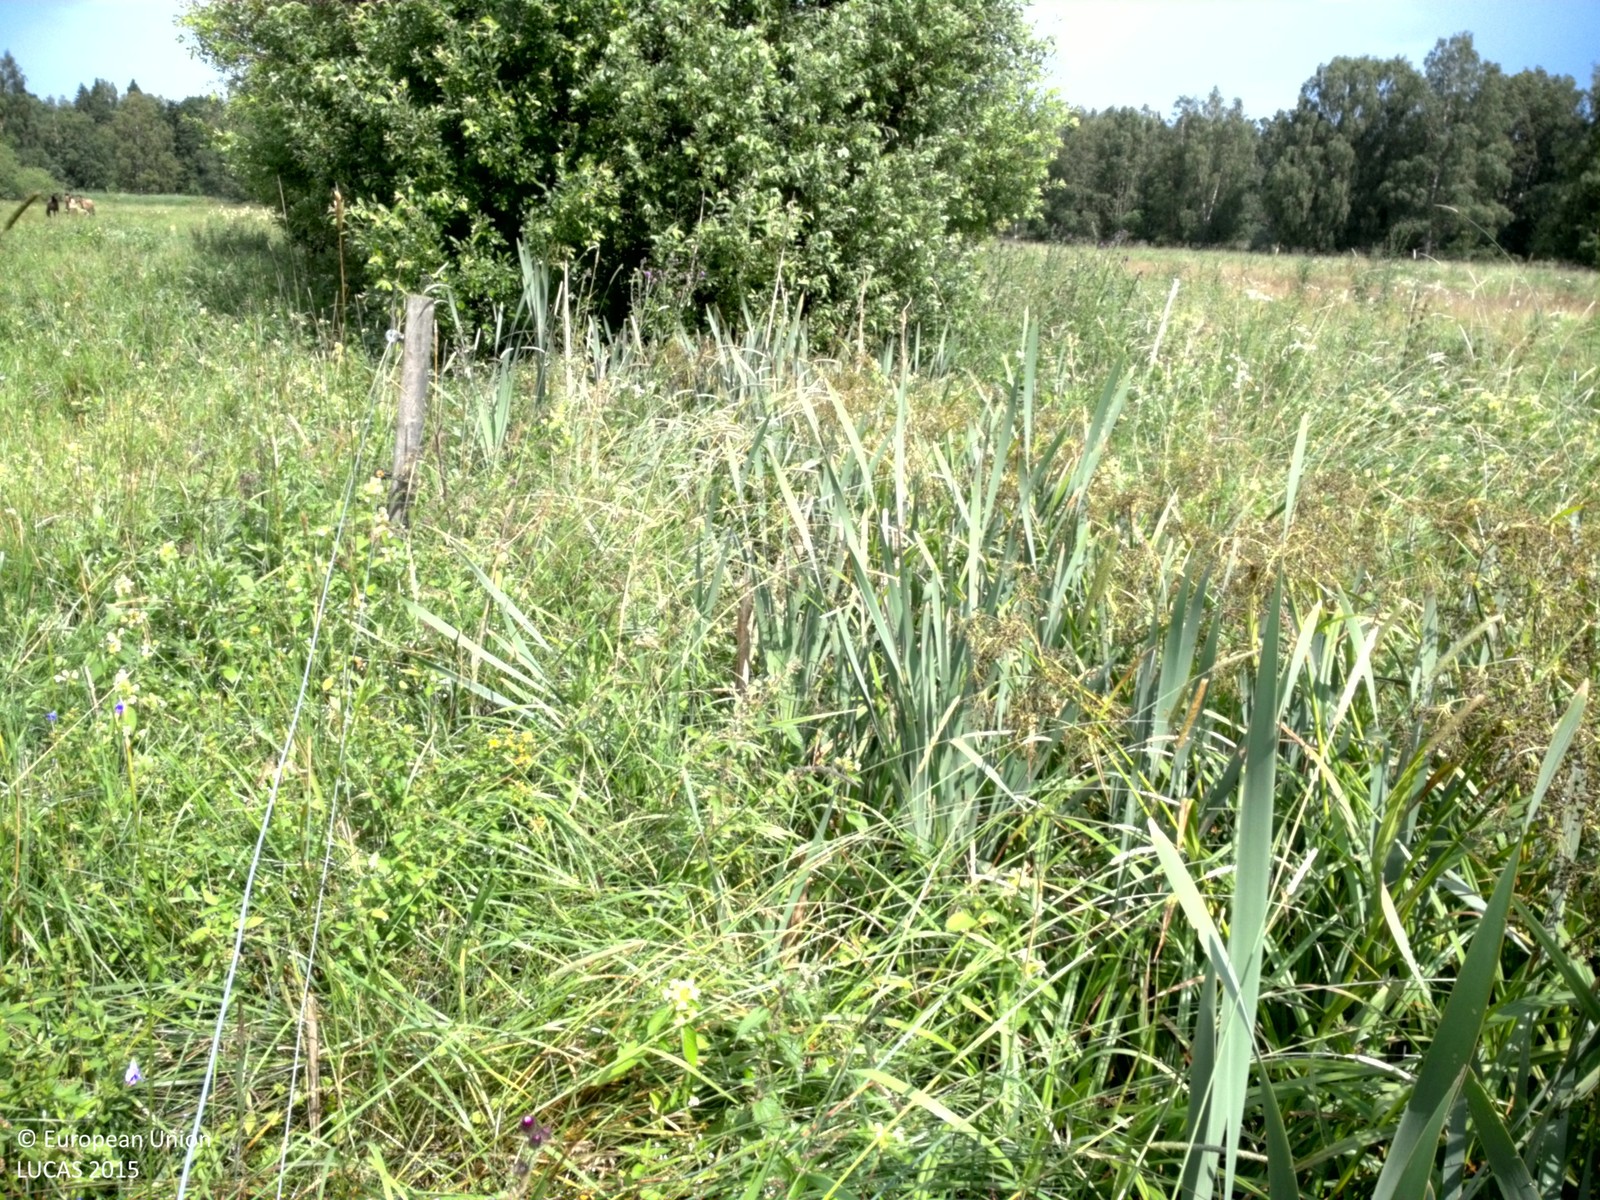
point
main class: Grassland
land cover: Grassland without tree/shrub cover
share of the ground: > 75 %
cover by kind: herbaceous plants 100 %
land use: Agriculture (excluding fallow land and kitchen gardens)
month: July
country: SE
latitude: 59.9534
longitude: 18.6108
